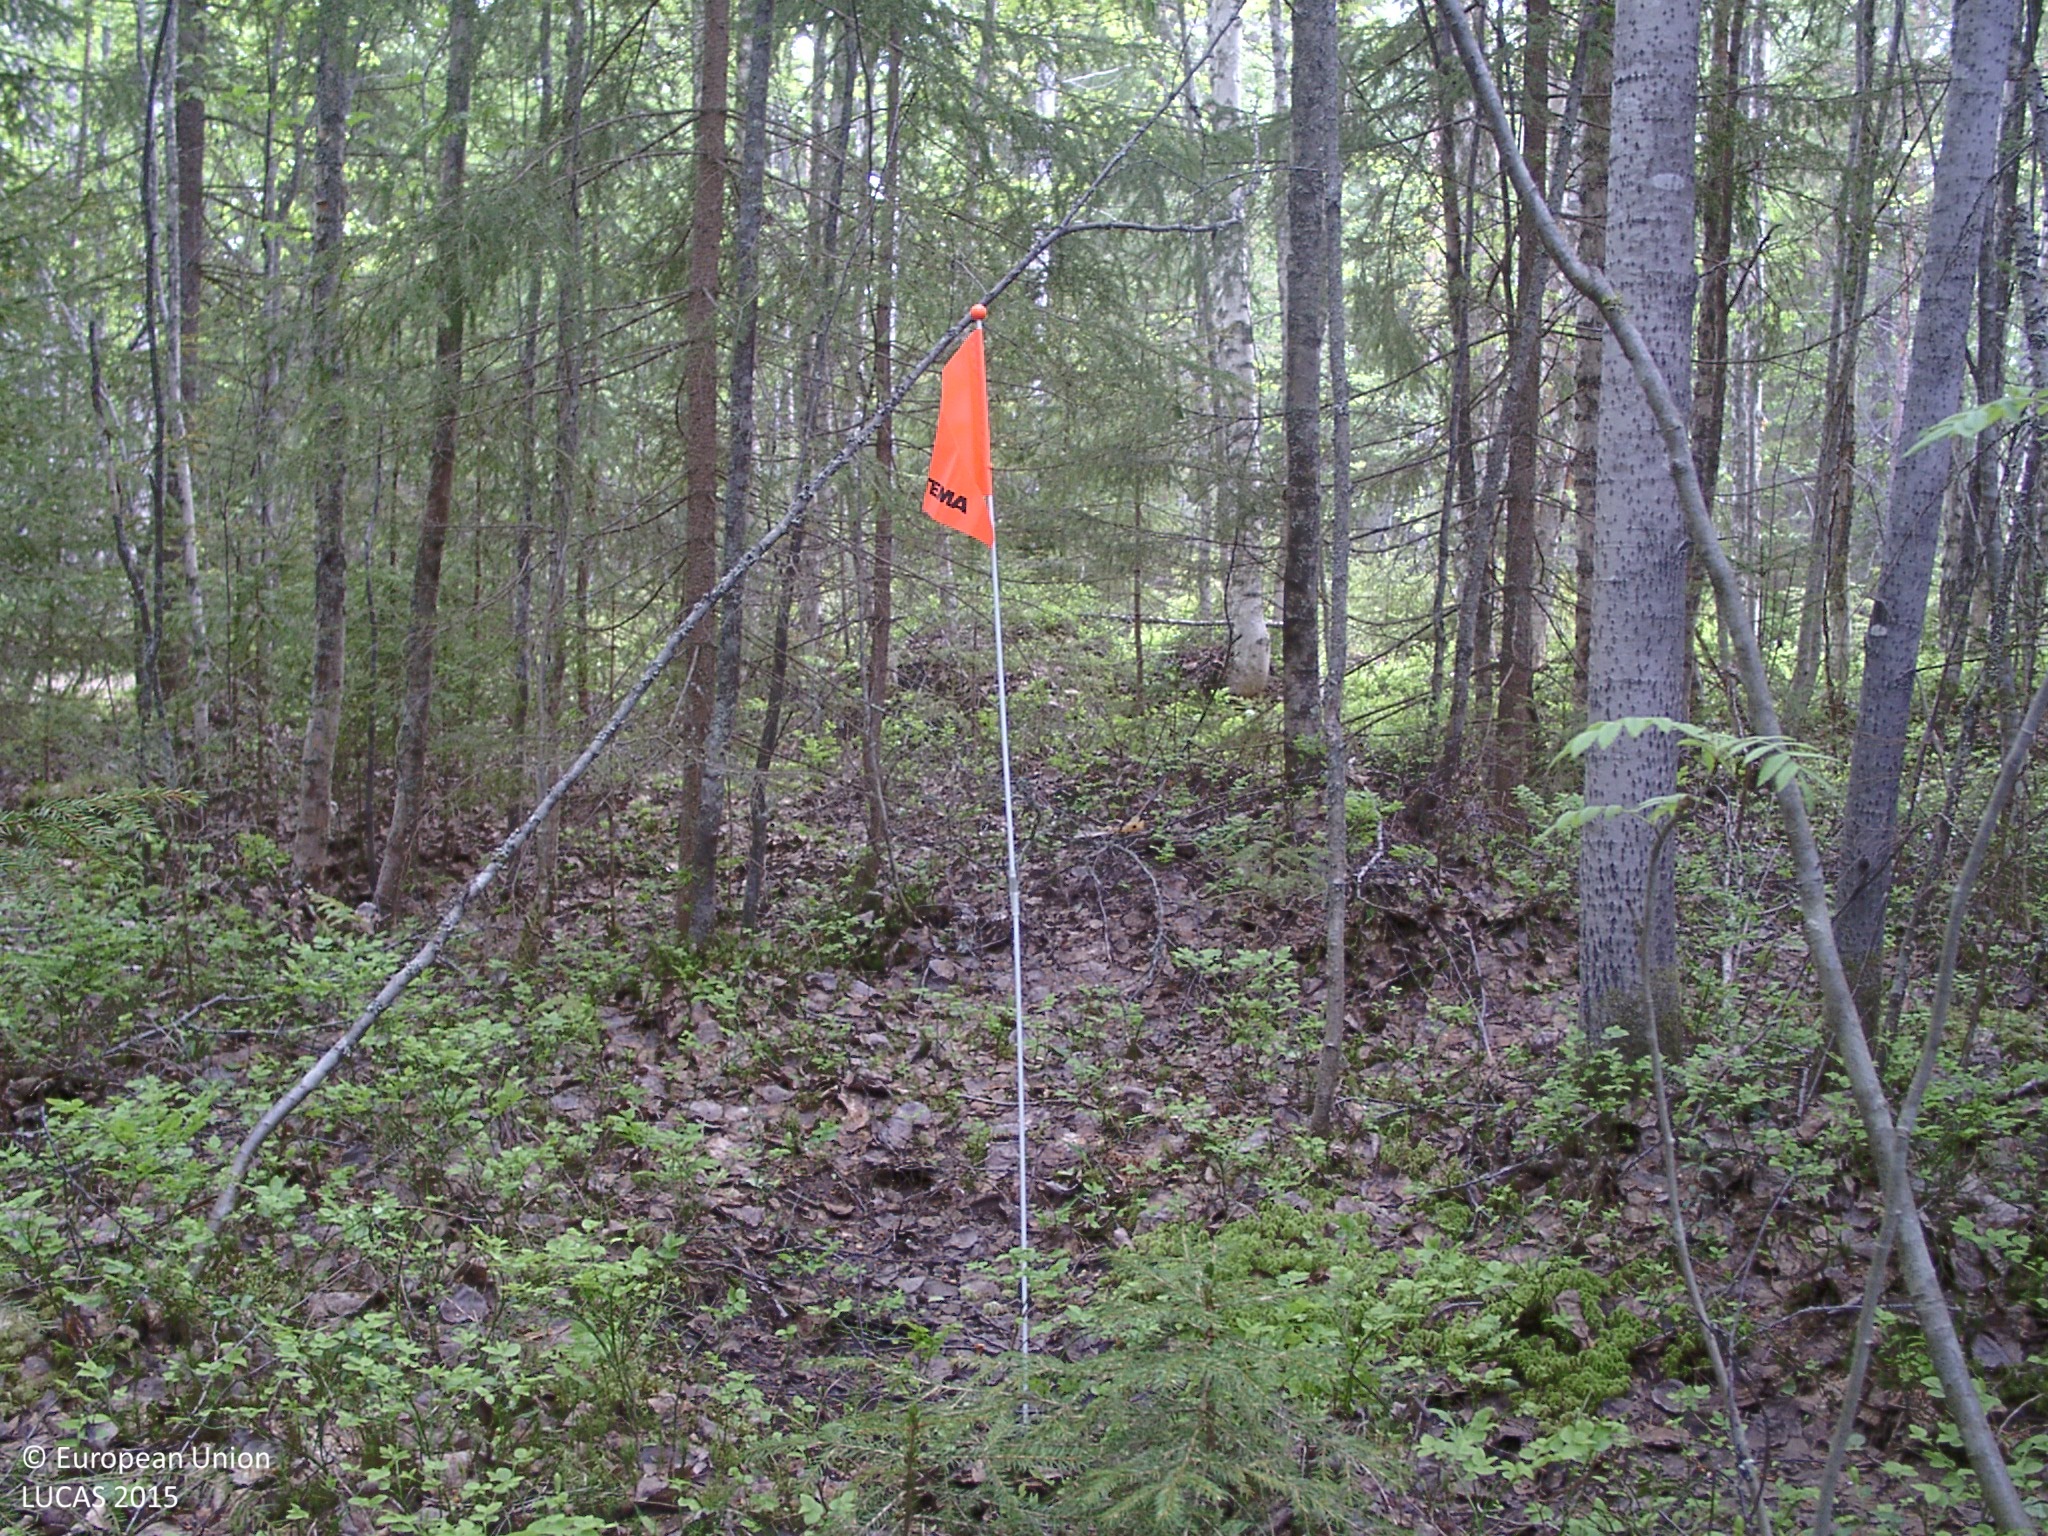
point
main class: Woodland
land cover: Spruce dominated mixed woodland
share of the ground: > 75 %
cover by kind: broadleaved forest trees 45 %, coniferous forest trees 35 %, shrubs 15 %, lichens and mosses 5 %
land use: Semi-natural and natural areas not in use
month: June
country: FI
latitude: 62.1327
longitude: 25.5150
